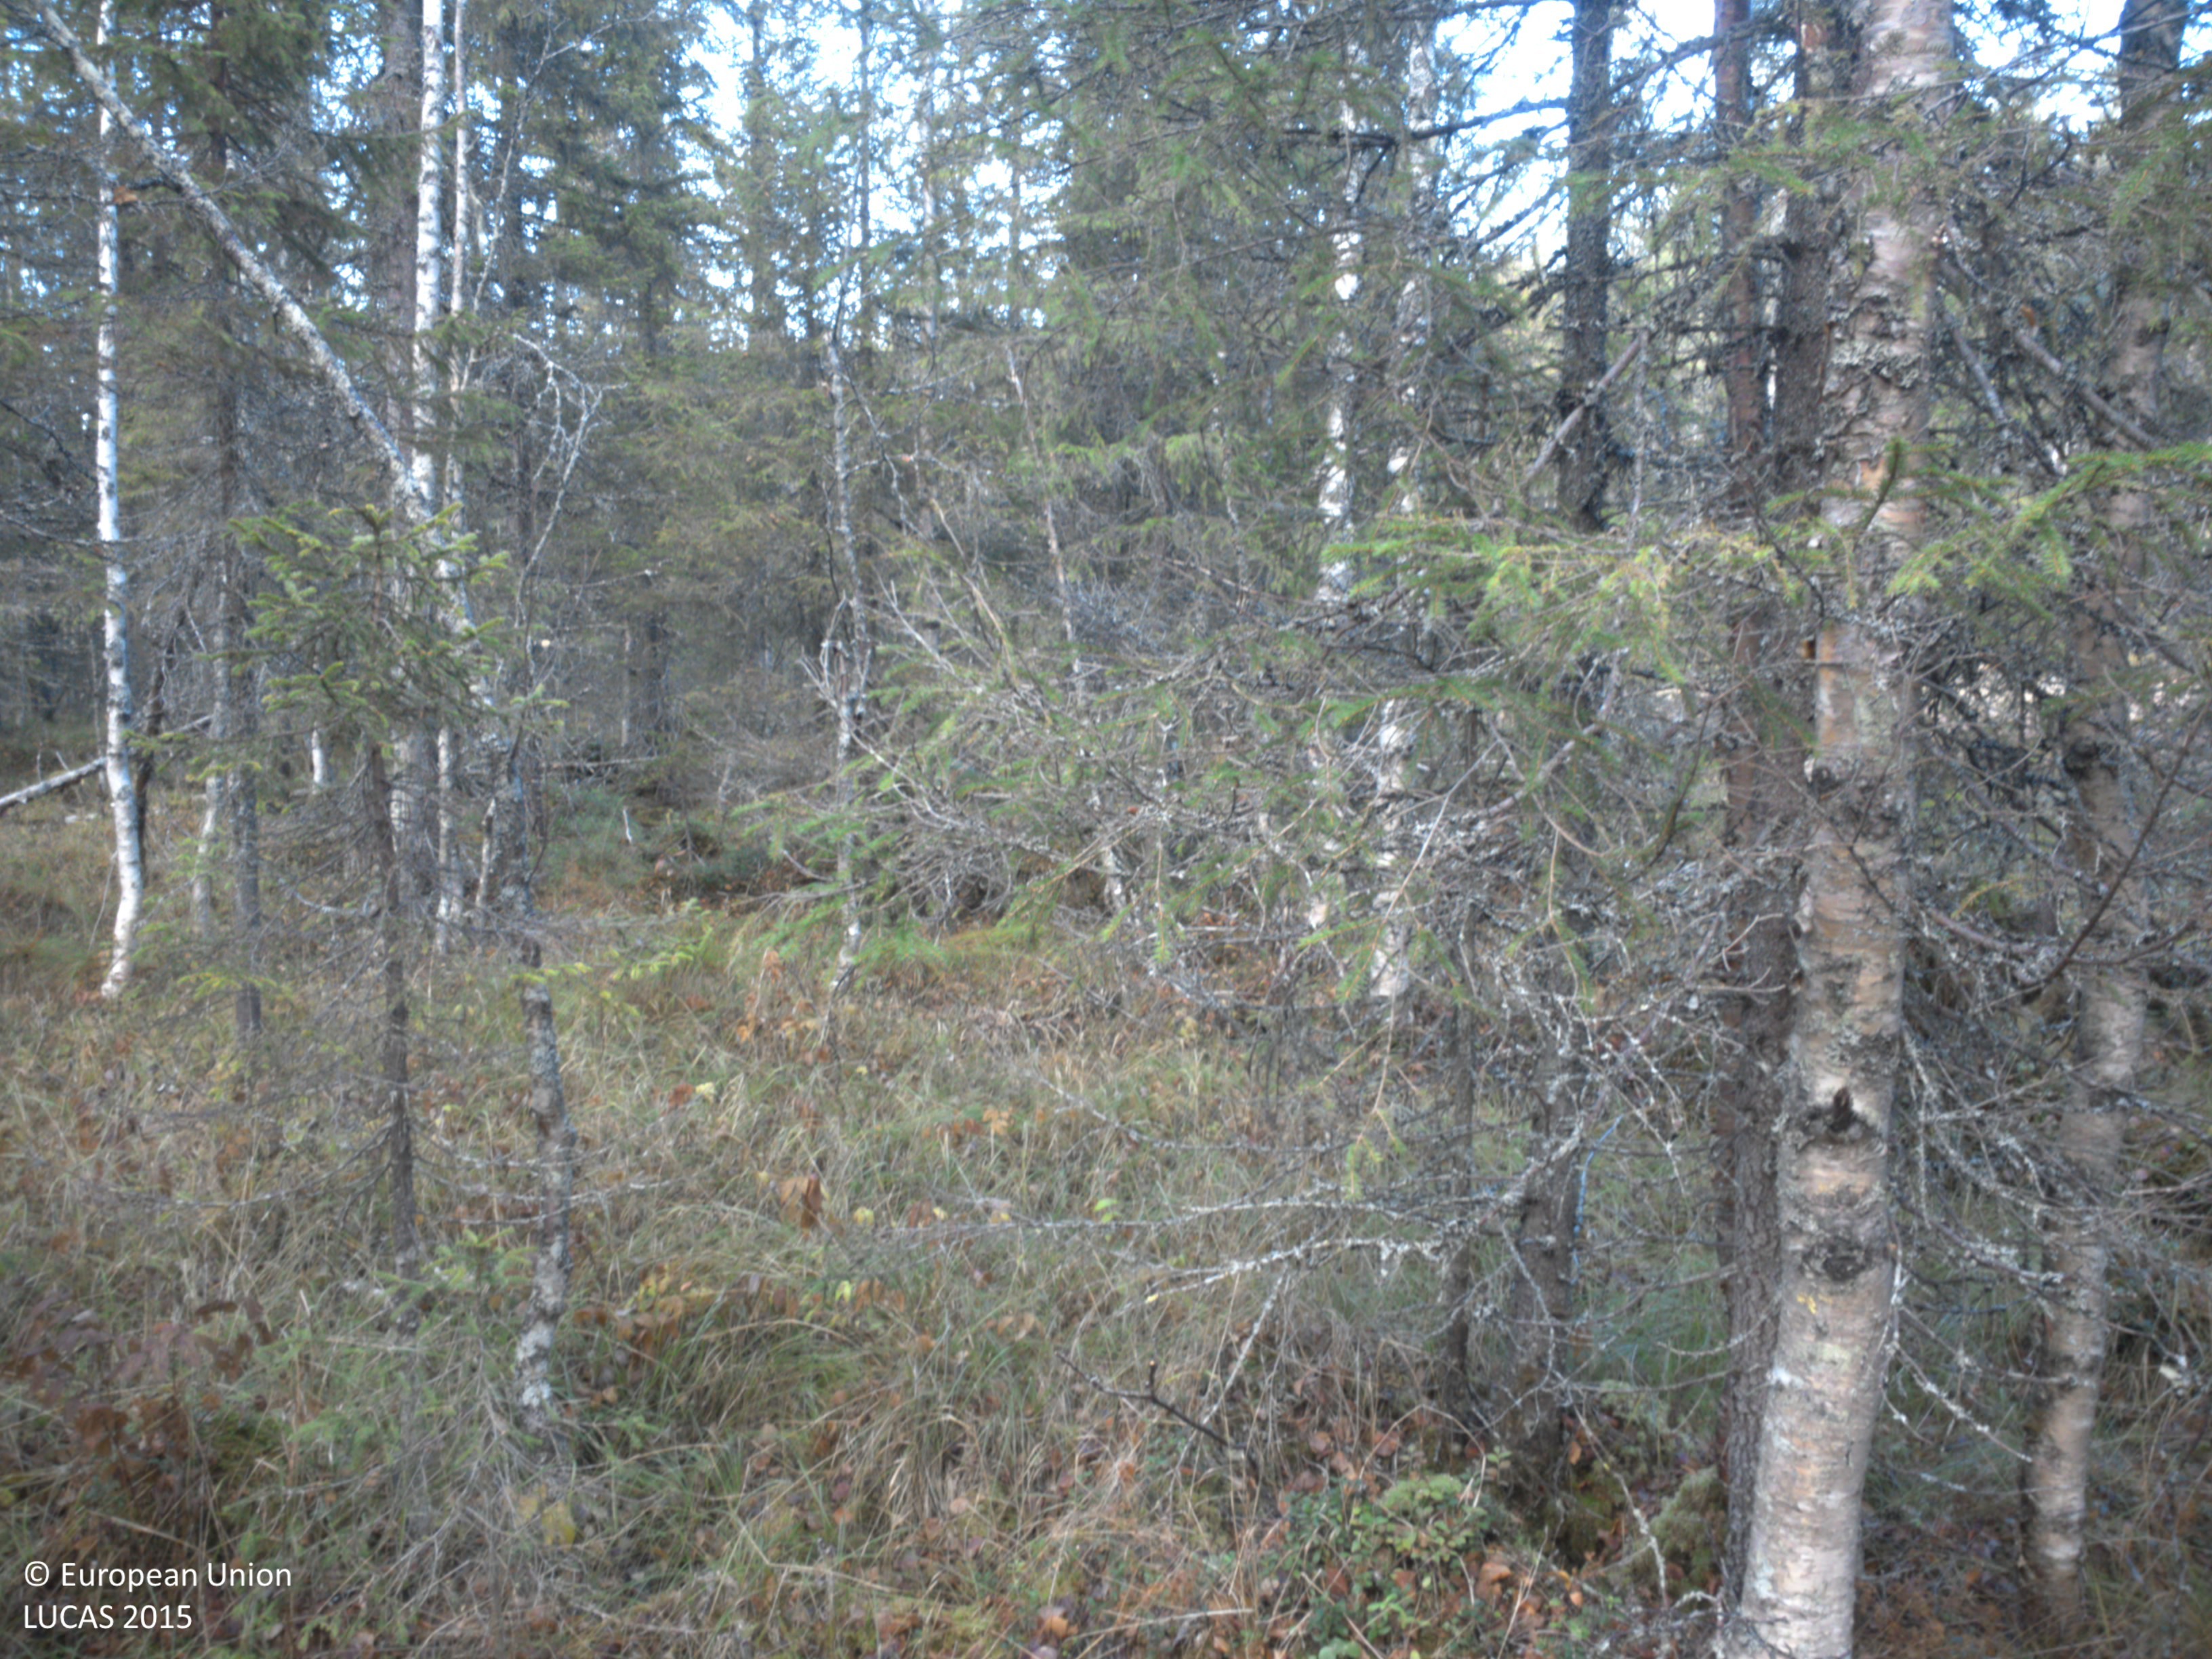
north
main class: Woodland
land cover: Spruce dominated mixed woodland
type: boreal forest
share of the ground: > 75 %
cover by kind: coniferous forest trees 55 %, broadleaved forest trees 25 %, shrubs 10 %, herbaceous plants 5 %, lichens and mosses 5 %
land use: Forestry
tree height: > 5 m
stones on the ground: < 10 %
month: October
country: SE
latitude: 64.0457
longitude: 18.1013
